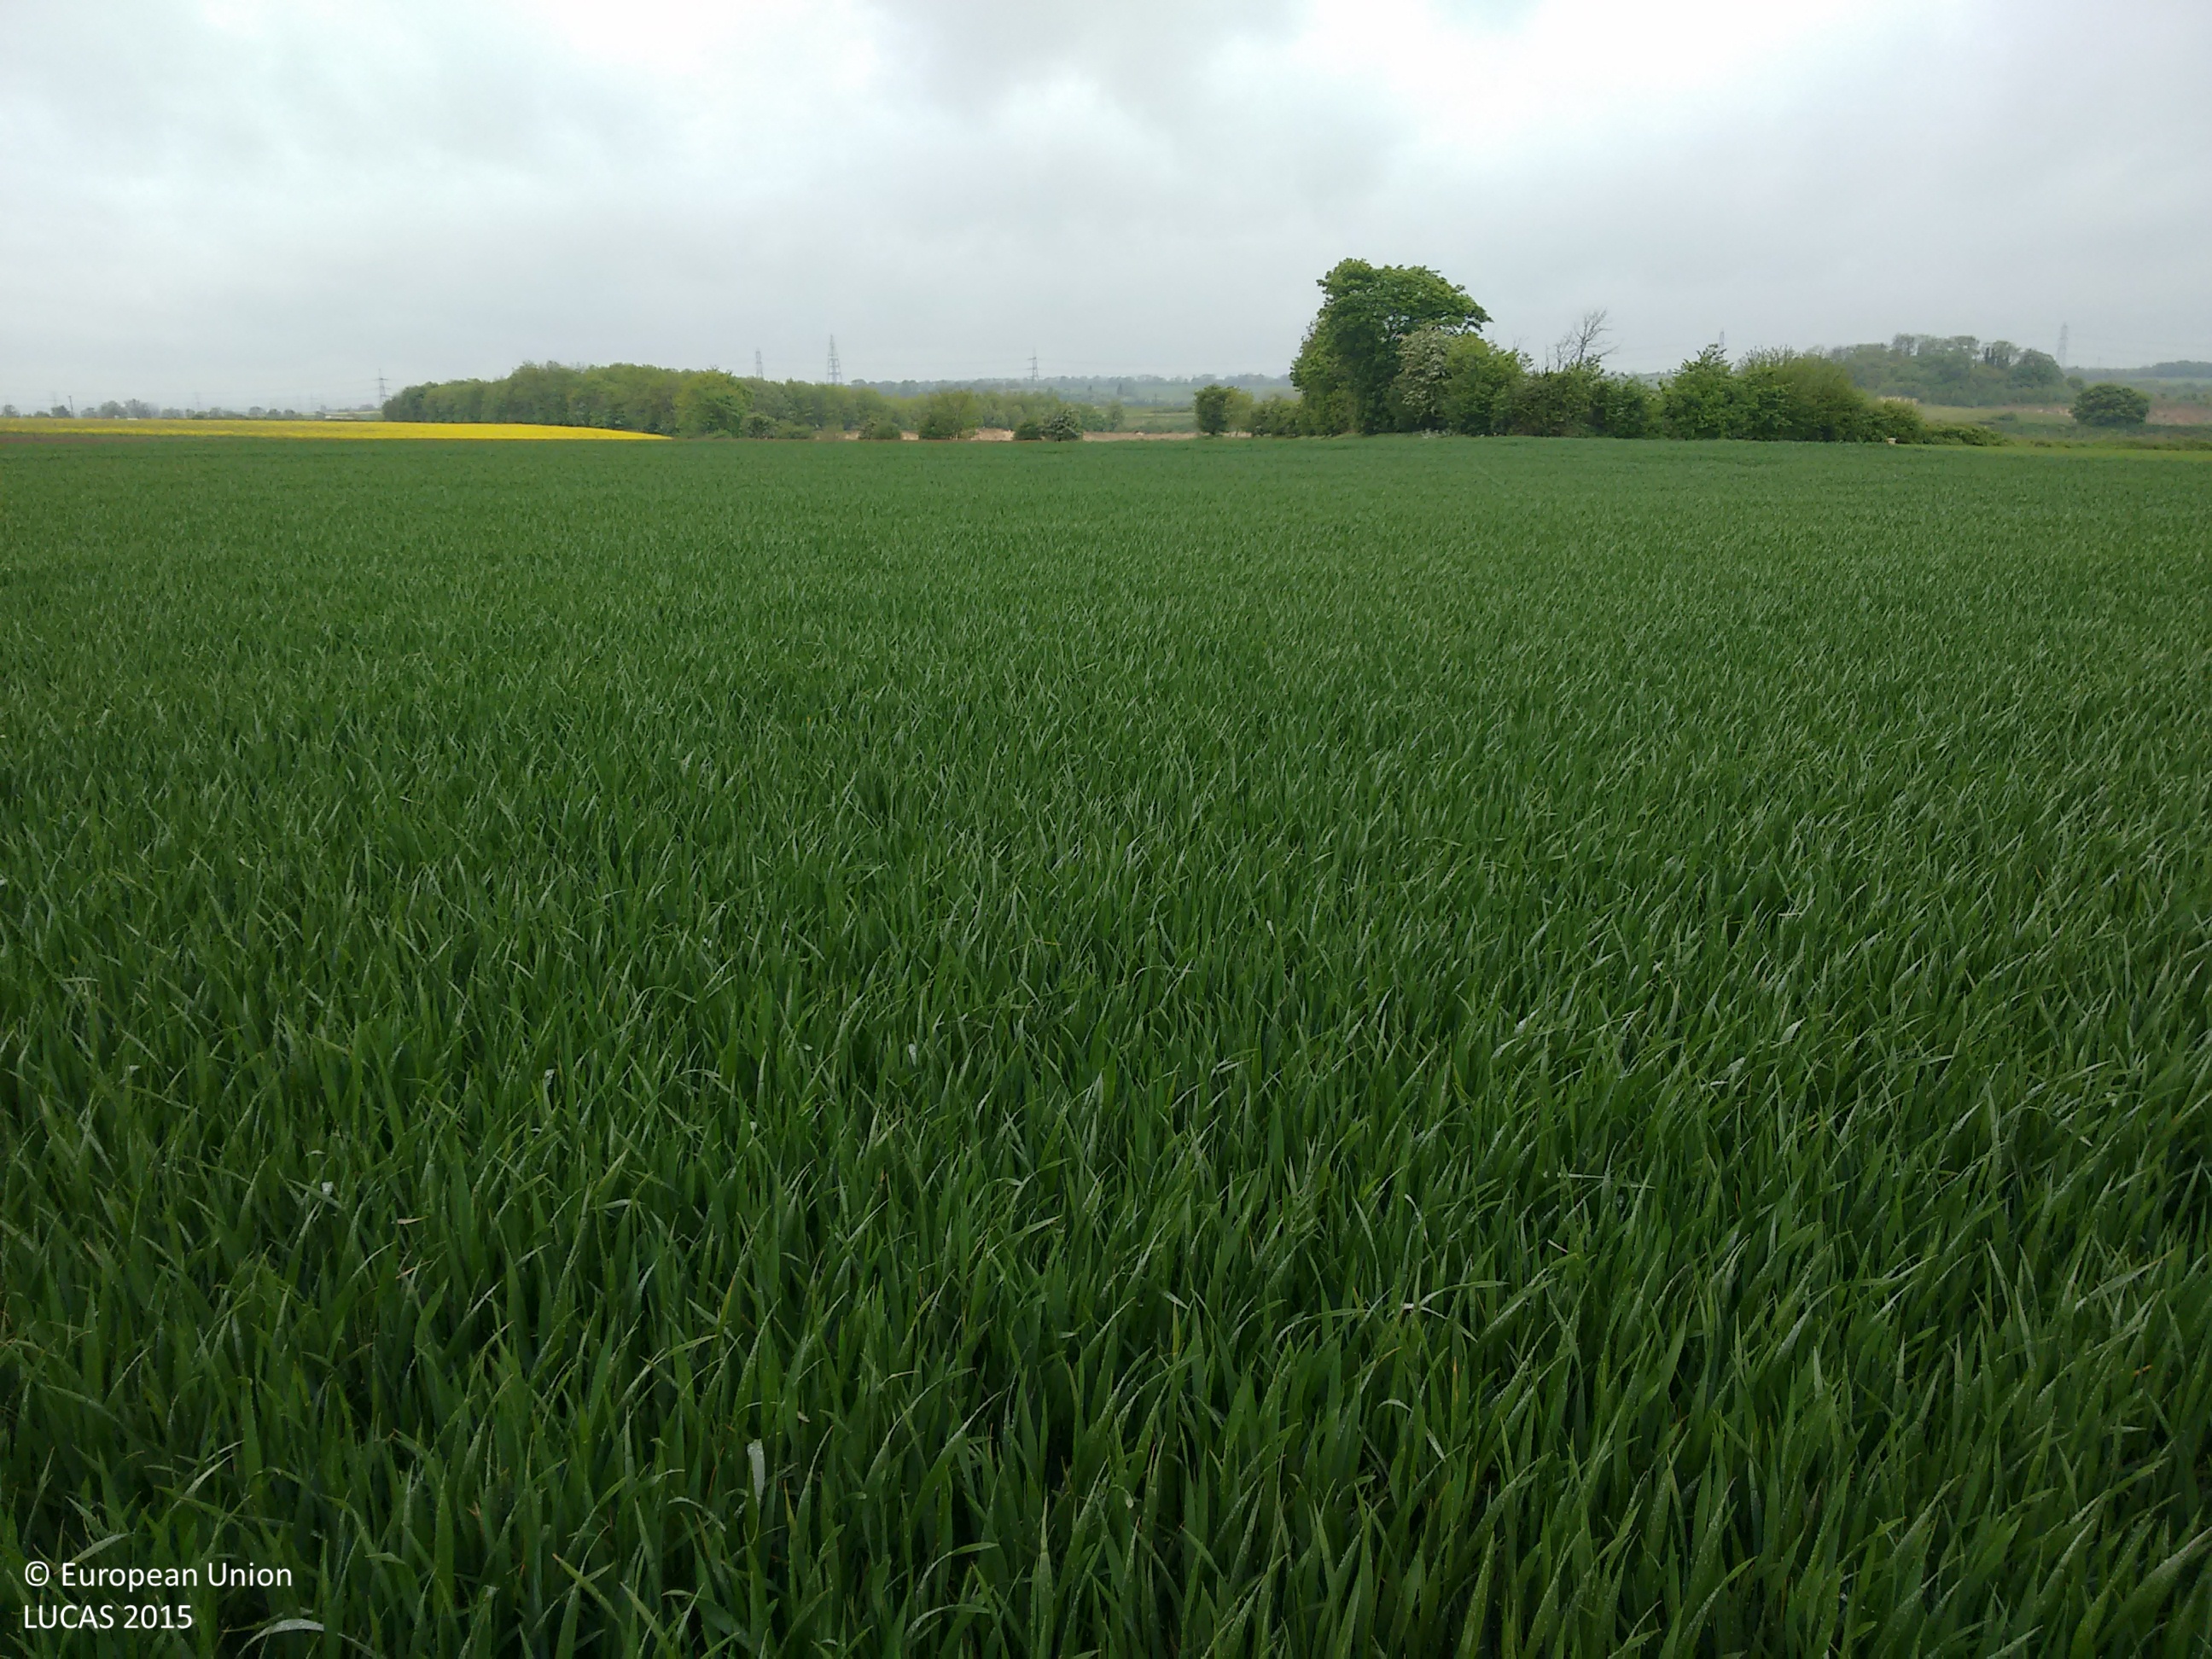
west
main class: Cropland
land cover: Common wheat
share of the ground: > 75 %
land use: Agriculture (excluding fallow land and kitchen gardens)
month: May
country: GB
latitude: 53.6232
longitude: -1.2193
